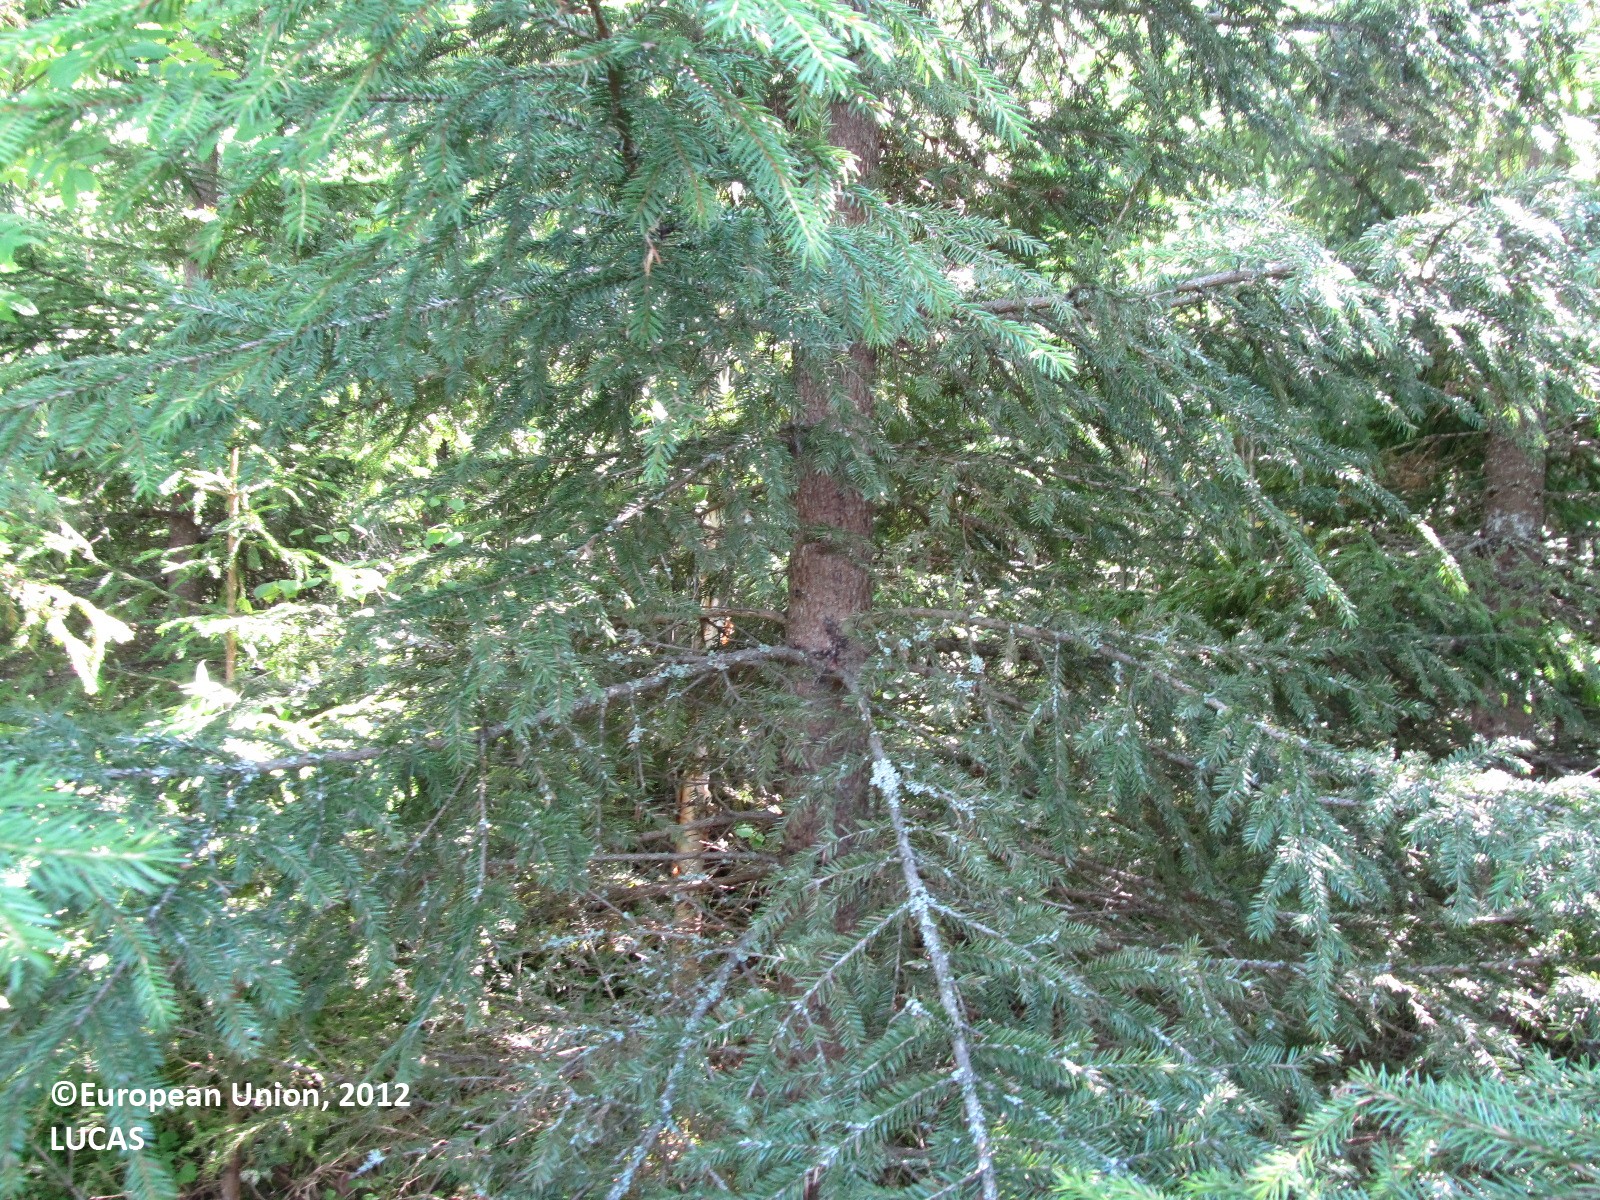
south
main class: Woodland
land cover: Spruce dominated mixed woodland
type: boreal forest
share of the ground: > 75 %
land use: Forestry
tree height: > 5 m
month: July
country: FI
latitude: 61.9427
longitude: 28.1277
